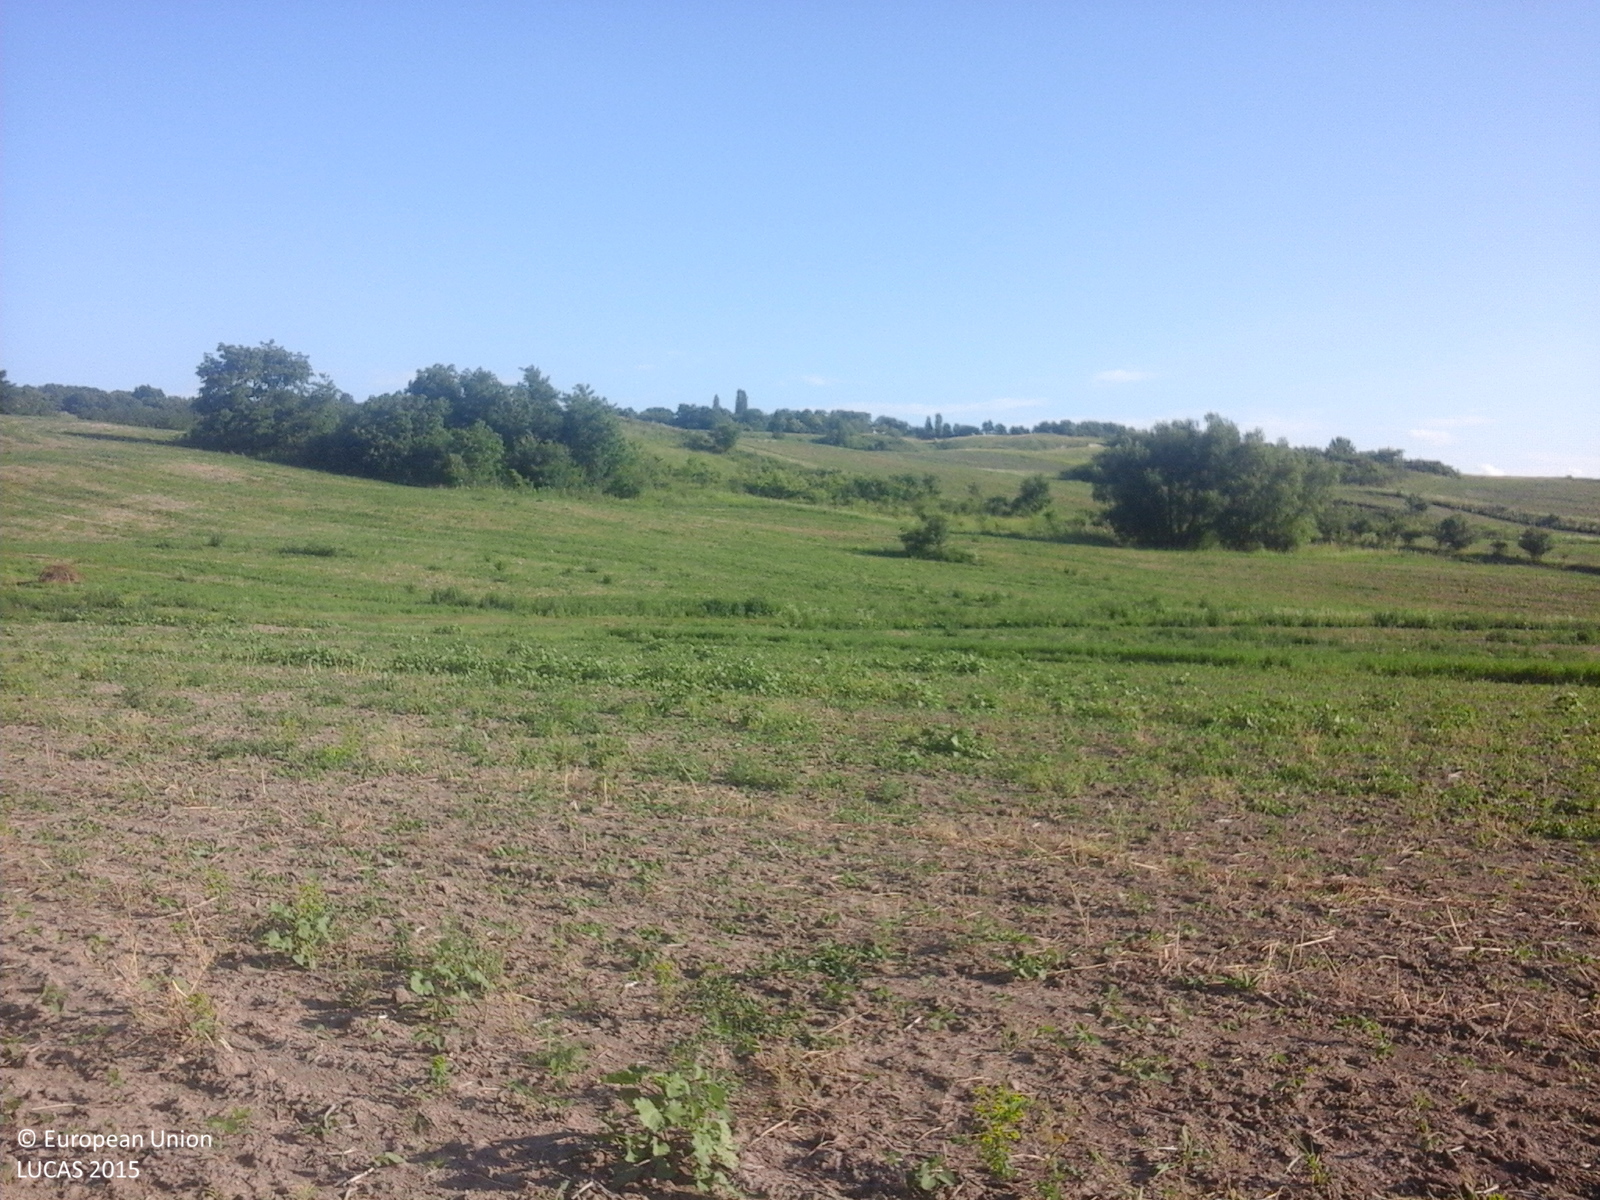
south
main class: Cropland
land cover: Soya
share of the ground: 10 - 25 %
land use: Agriculture (excluding fallow land and kitchen gardens)
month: June
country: RO
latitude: 48.2364
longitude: 26.6171
